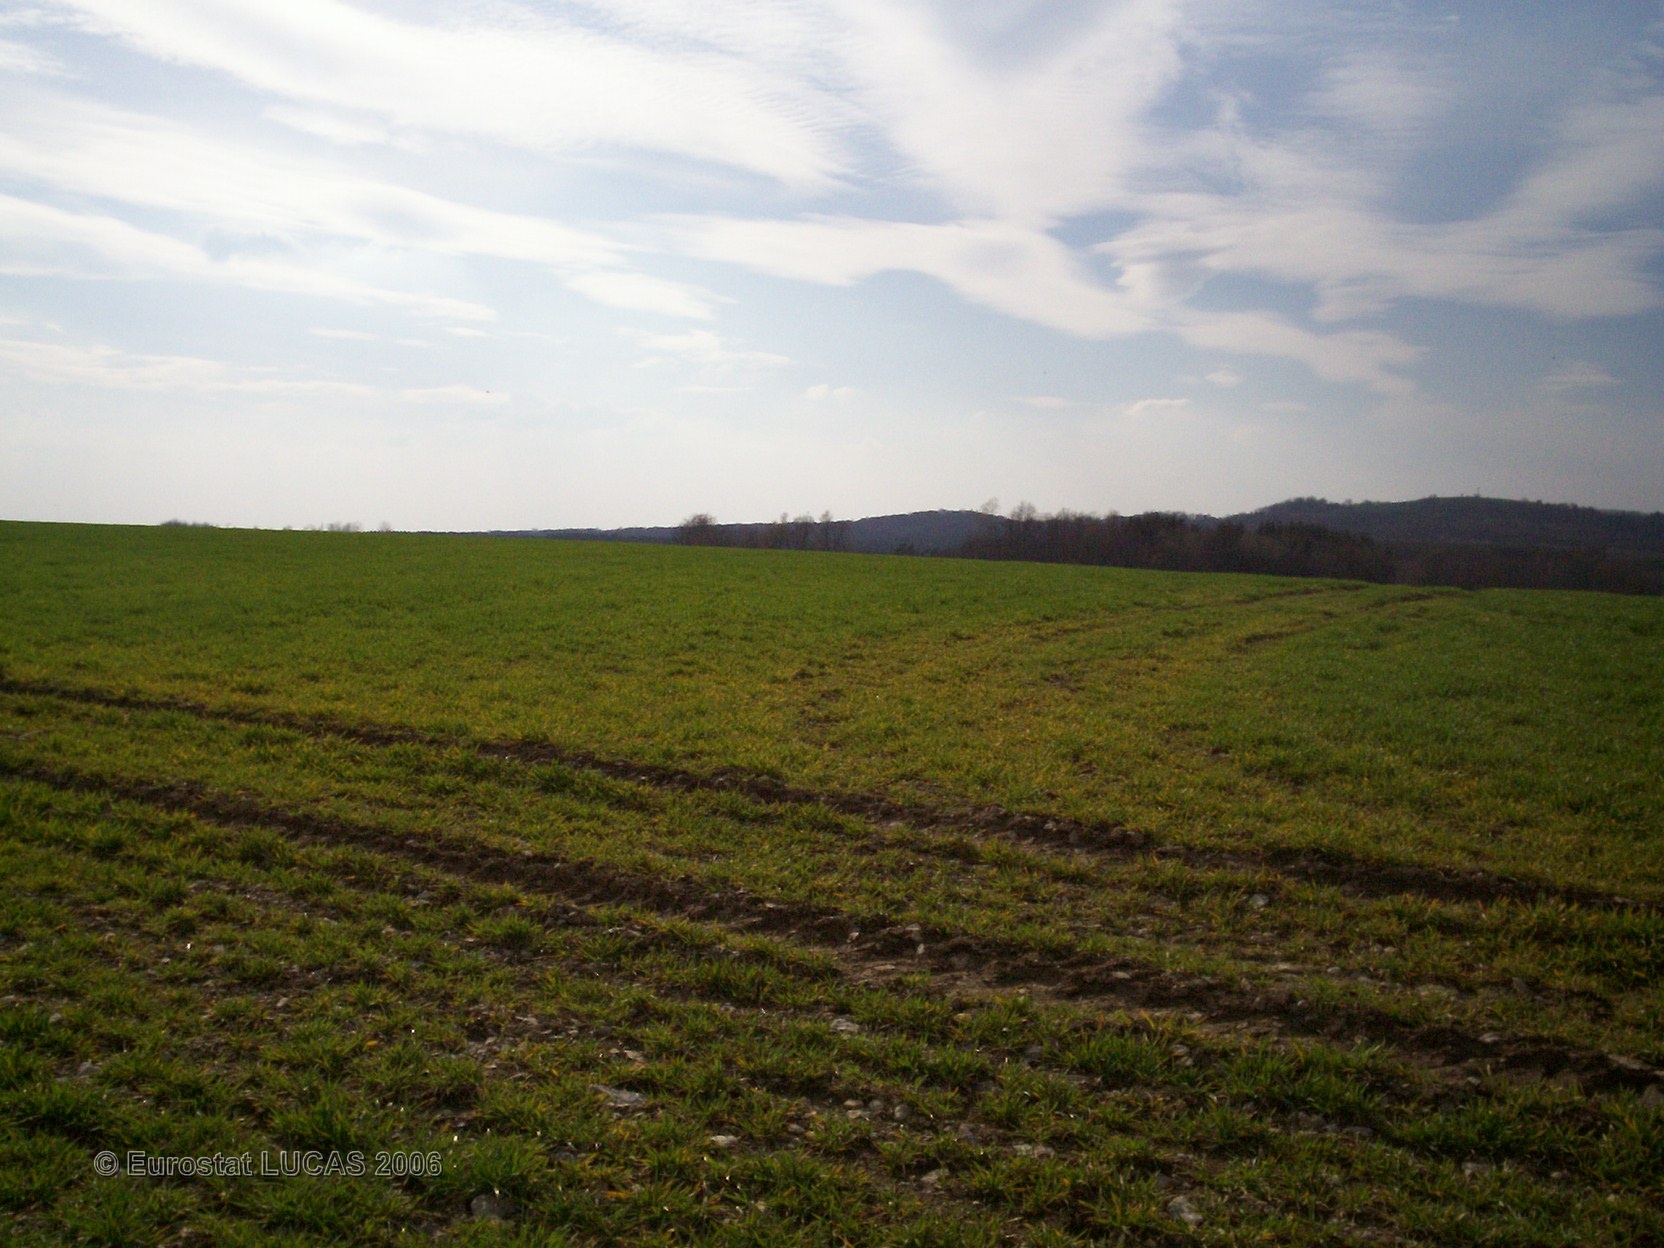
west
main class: Cropland
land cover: Common wheat
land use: Agriculture (excluding fallow land and kitchen gardens)
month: April
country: FR
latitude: 48.2344
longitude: 6.3250
